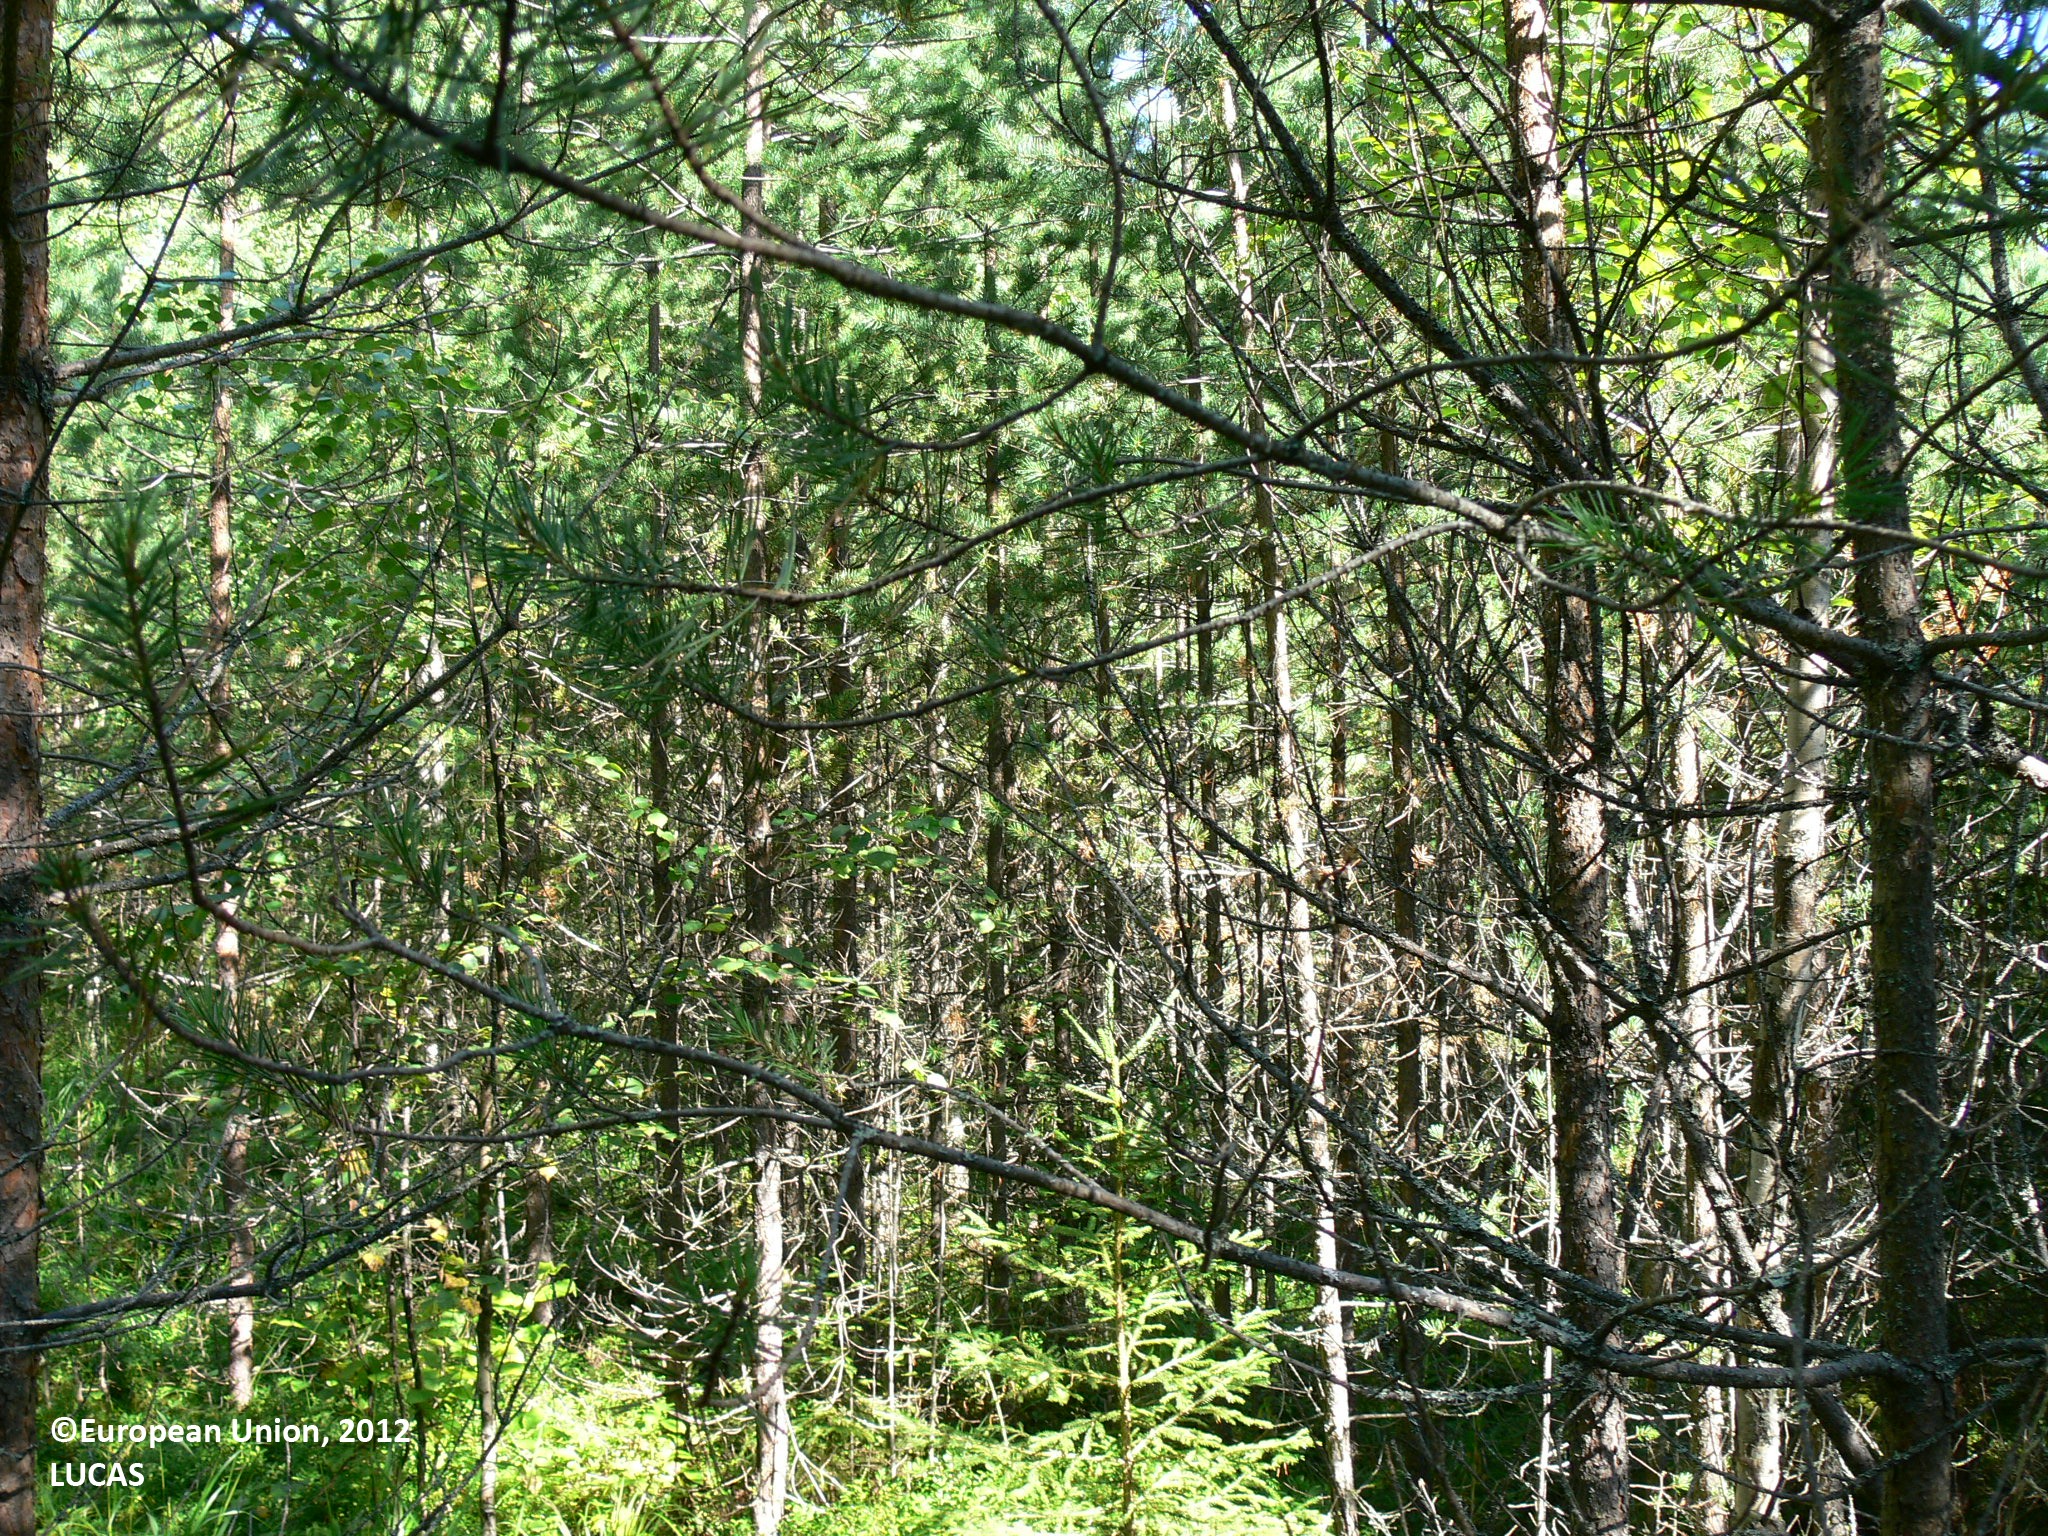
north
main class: Woodland
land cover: Pine dominated mixed woodland
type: boreal forest
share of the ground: 50 - 75 %
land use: Forestry
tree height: > 5 m
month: August
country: FI
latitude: 63.1560
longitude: 29.5885
